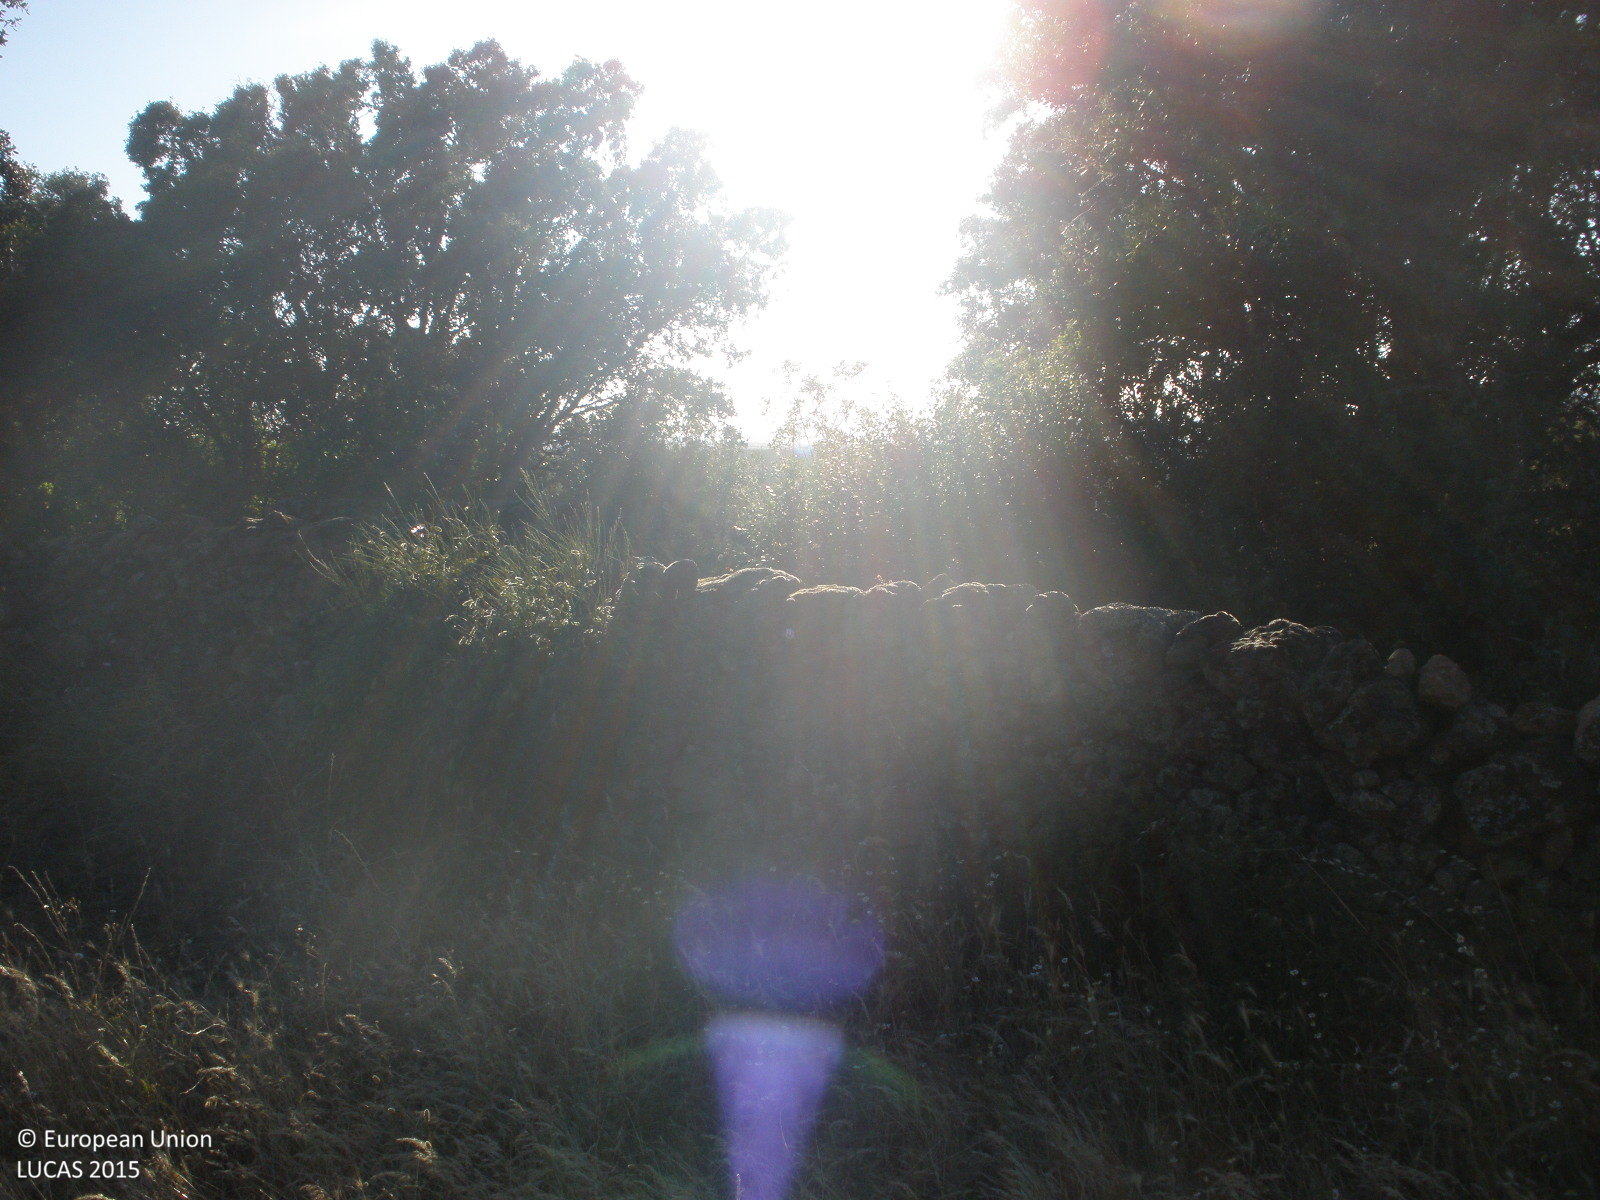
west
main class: Woodland
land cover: Broadleaved woodland
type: broadleaved evergreen forest
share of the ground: 25 - 50 %
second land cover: Grassland without tree/shrub cover
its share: > 75 %
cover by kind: herbaceous plants 60 %, broadleaved forest trees 40 %
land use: Forestry
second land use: Agriculture (excluding fallow land and kitchen gardens)
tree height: > 5 m
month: May
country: ES
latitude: 40.1885
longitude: -6.1551
